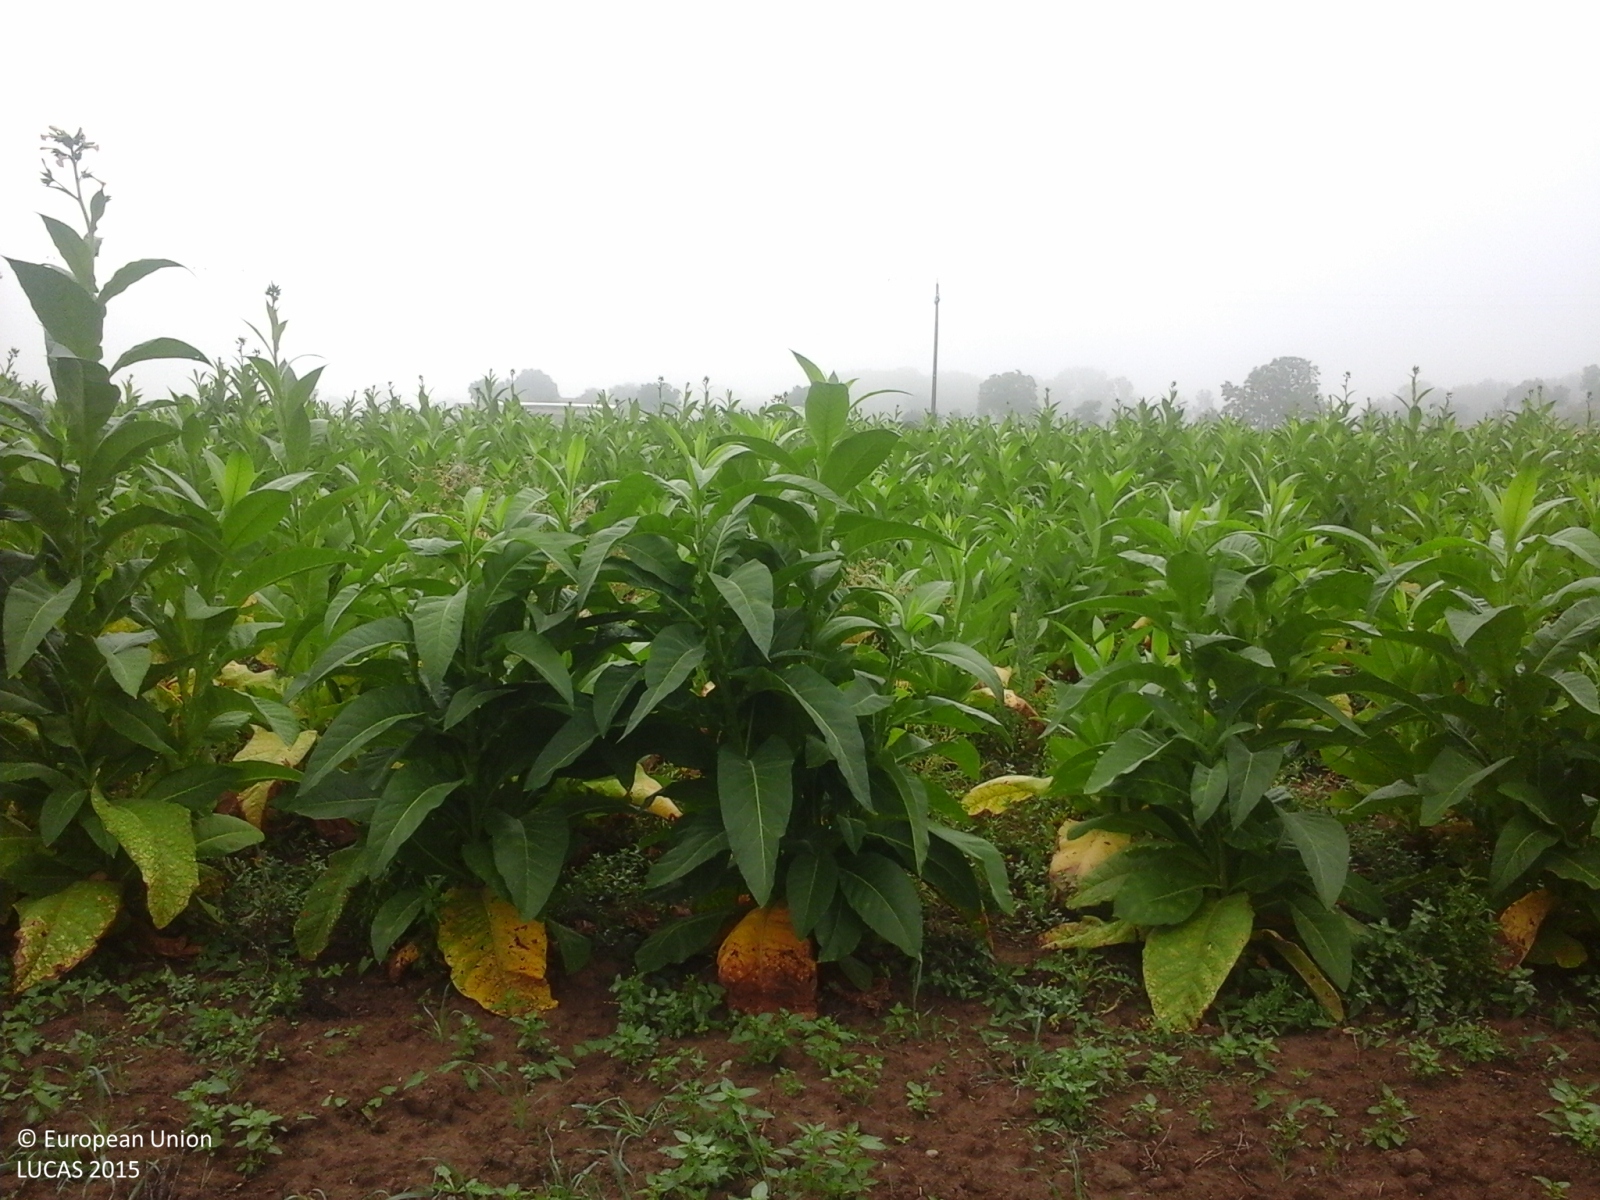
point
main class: Cropland
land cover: Tobacco
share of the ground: > 75 %
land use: Agriculture (excluding fallow land and kitchen gardens)
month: October
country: IT
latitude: 43.5170
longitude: 12.1098
